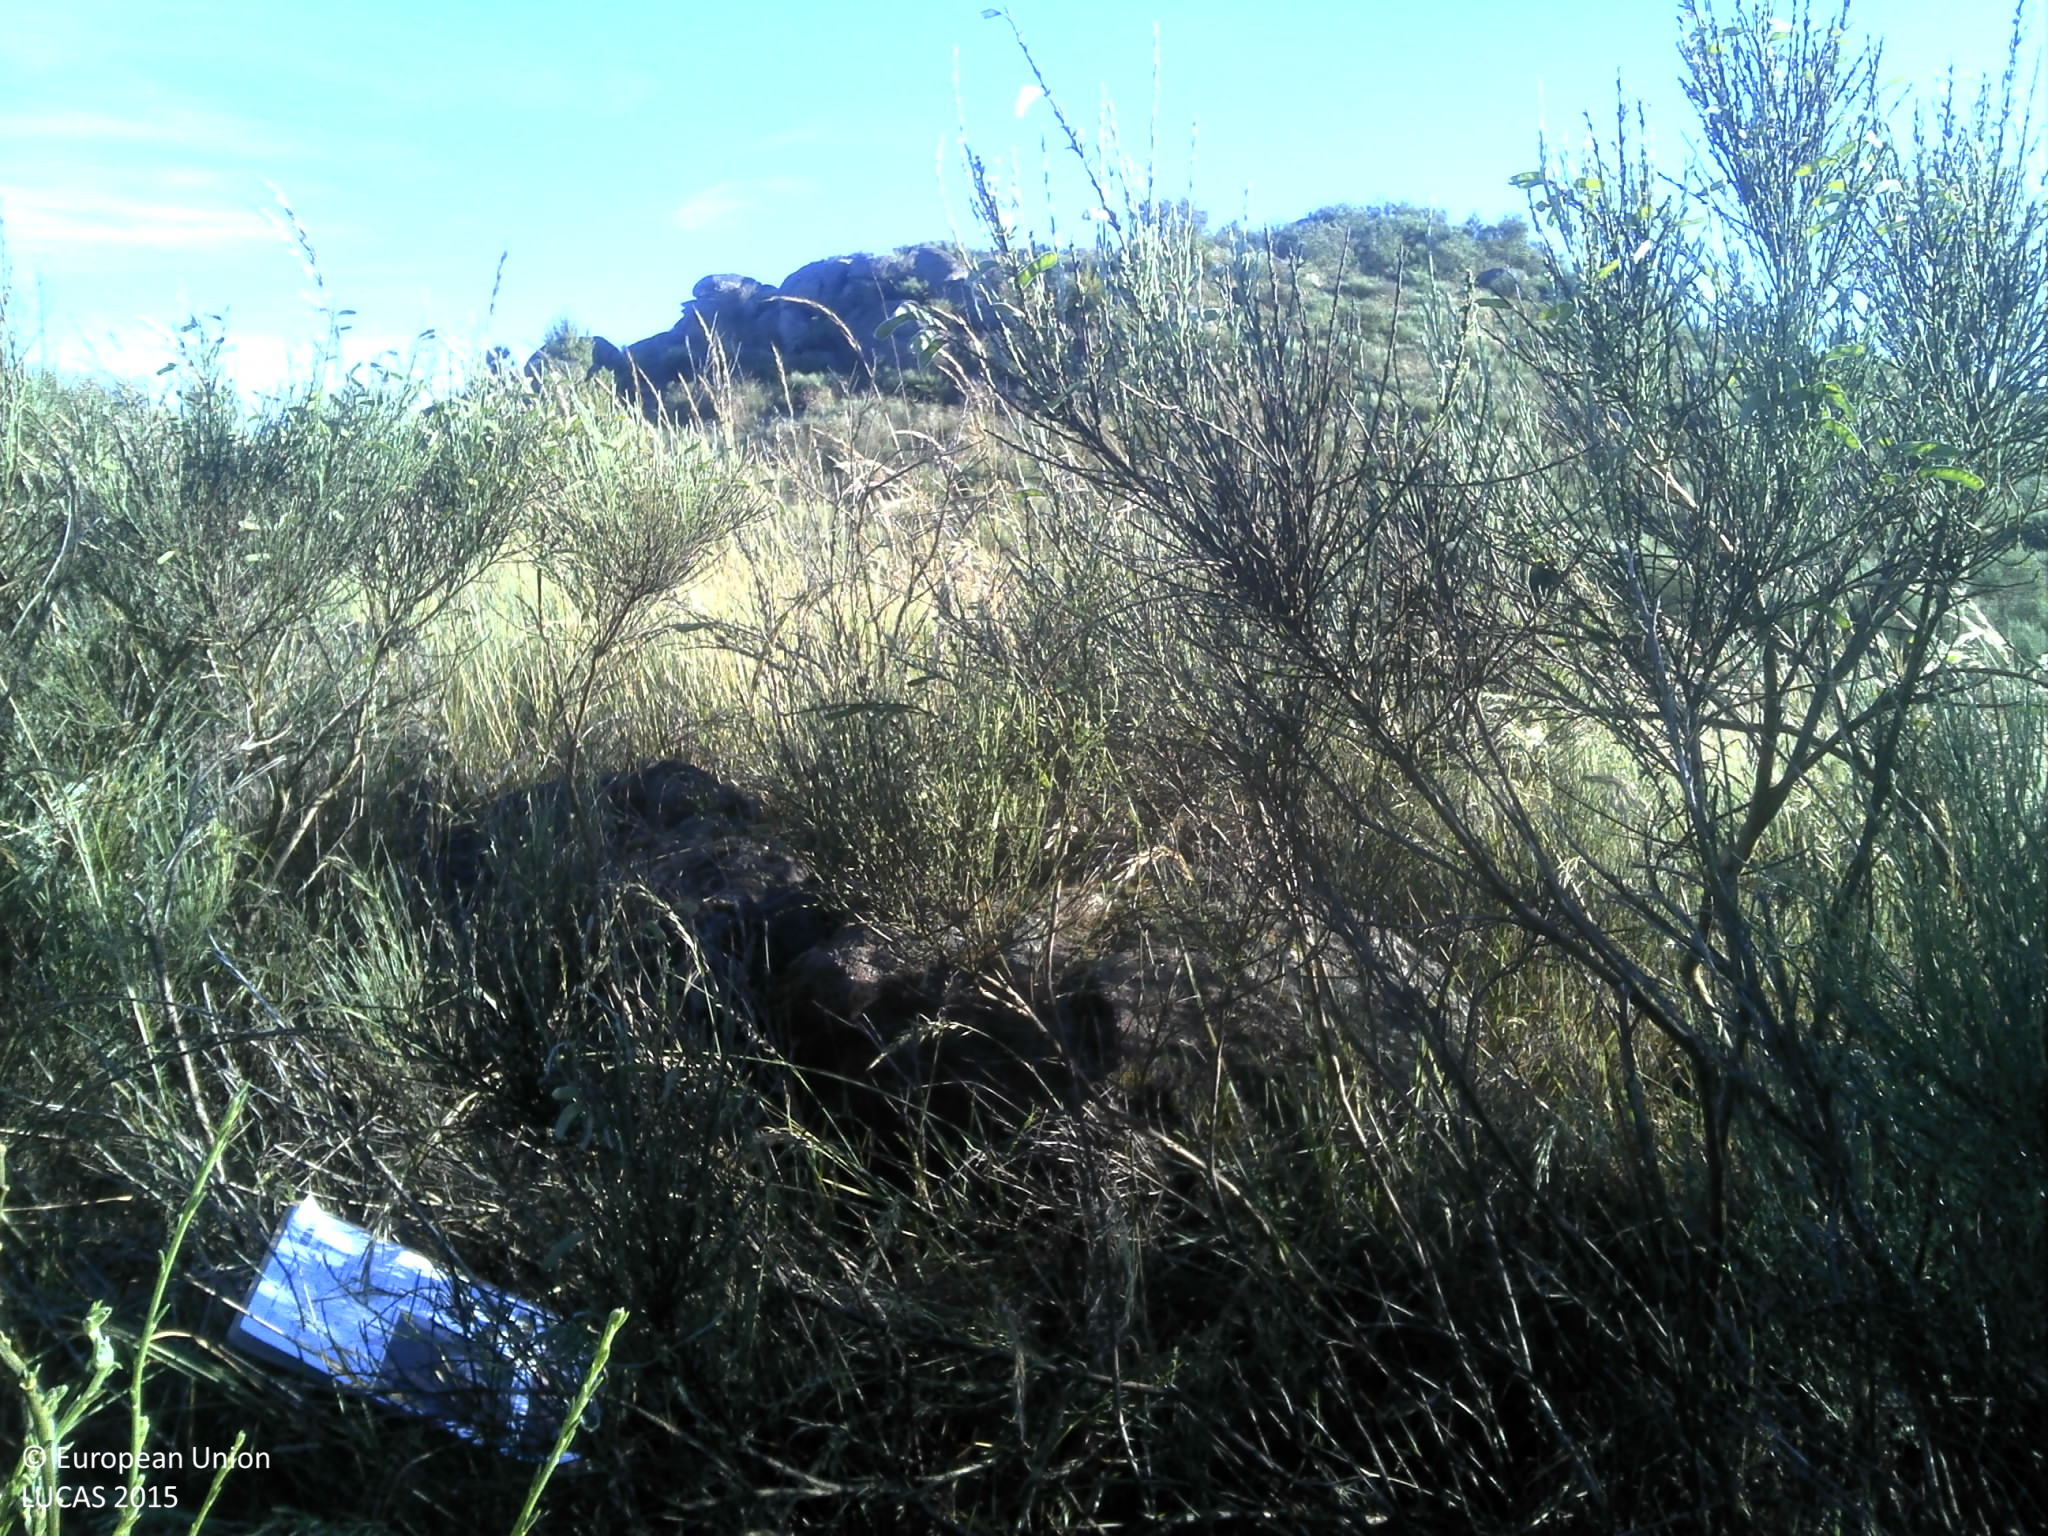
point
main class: Shrubland
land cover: Shrubland without tree cover
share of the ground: 50 - 75 %
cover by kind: shrubs 70 %, herbaceous plants 10 %, unconsolidated bare surface 10 %
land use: Agriculture (excluding fallow land and kitchen gardens)
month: May
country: PT
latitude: 40.5790
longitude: -7.5142
